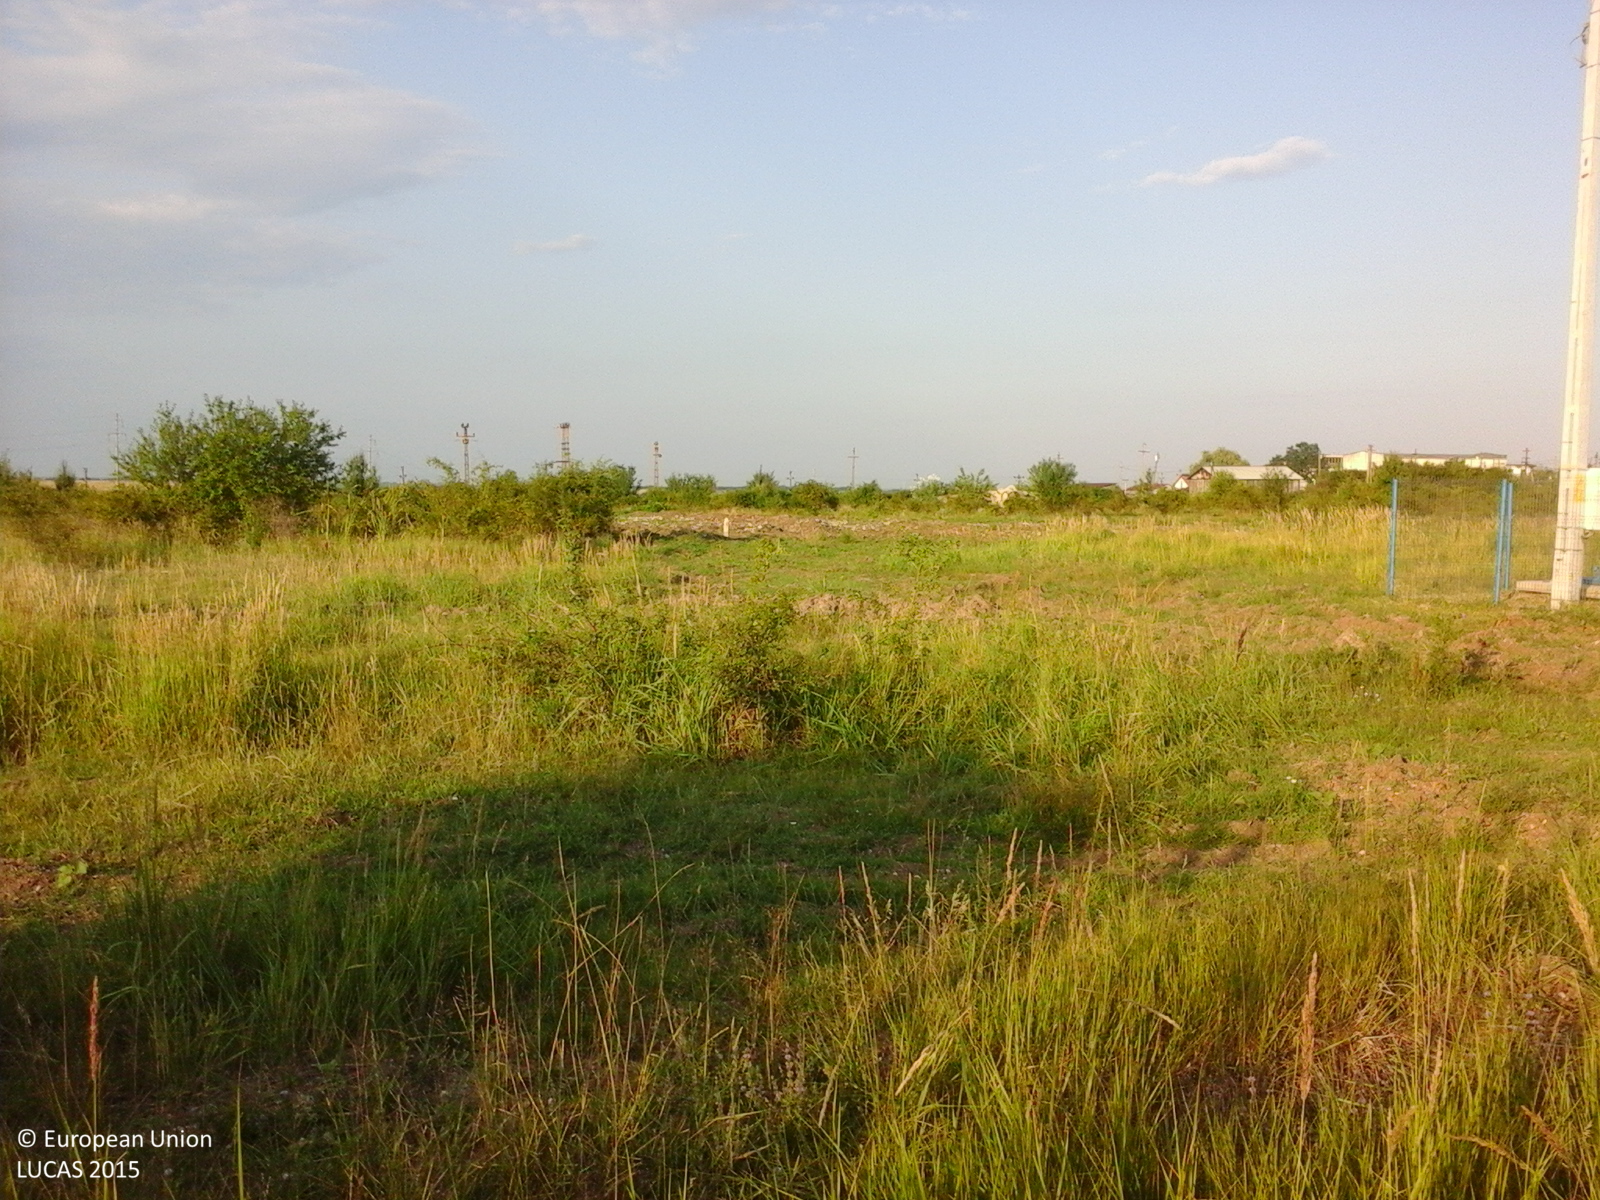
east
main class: Grassland
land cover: Spontaneously vegetated surfaces
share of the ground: > 75 %
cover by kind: herbaceous plants 100 %
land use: Semi-natural and natural areas not in use
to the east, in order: Spontaneously vegetated surfaces; Electric lines; Spontaneously vegetated surfaces; Ditches and canals; Abandoned hedges; Spontaneously vegetated surfaces; Electric lines; Tracks; Grassland with sparse tree/shrub cover; Artificial constructions in urban areas
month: July
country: RO
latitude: 44.4130
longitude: 24.7047
